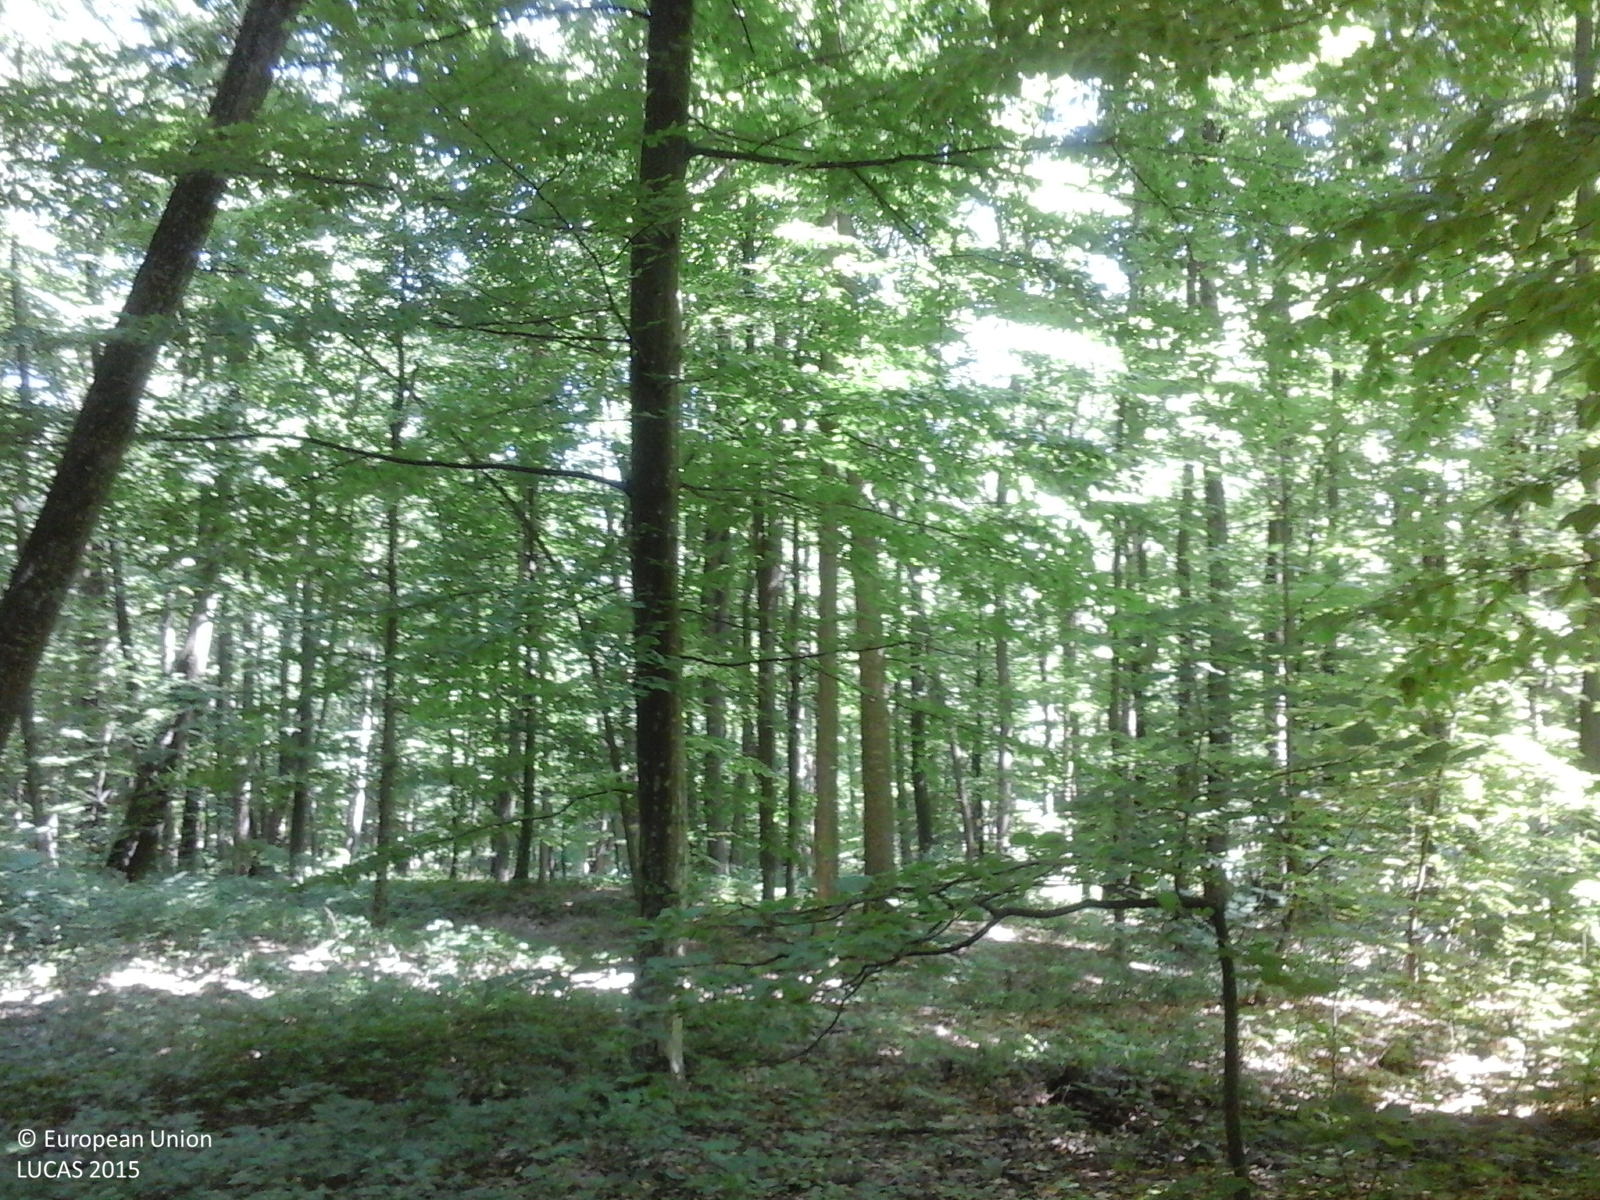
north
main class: Woodland
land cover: Broadleaved woodland
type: thermophilous deciduous forest
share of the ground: > 75 %
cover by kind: broadleaved forest trees 100 %
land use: Forestry
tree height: > 5 m
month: June
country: RO
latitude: 47.0930
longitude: 27.1111
